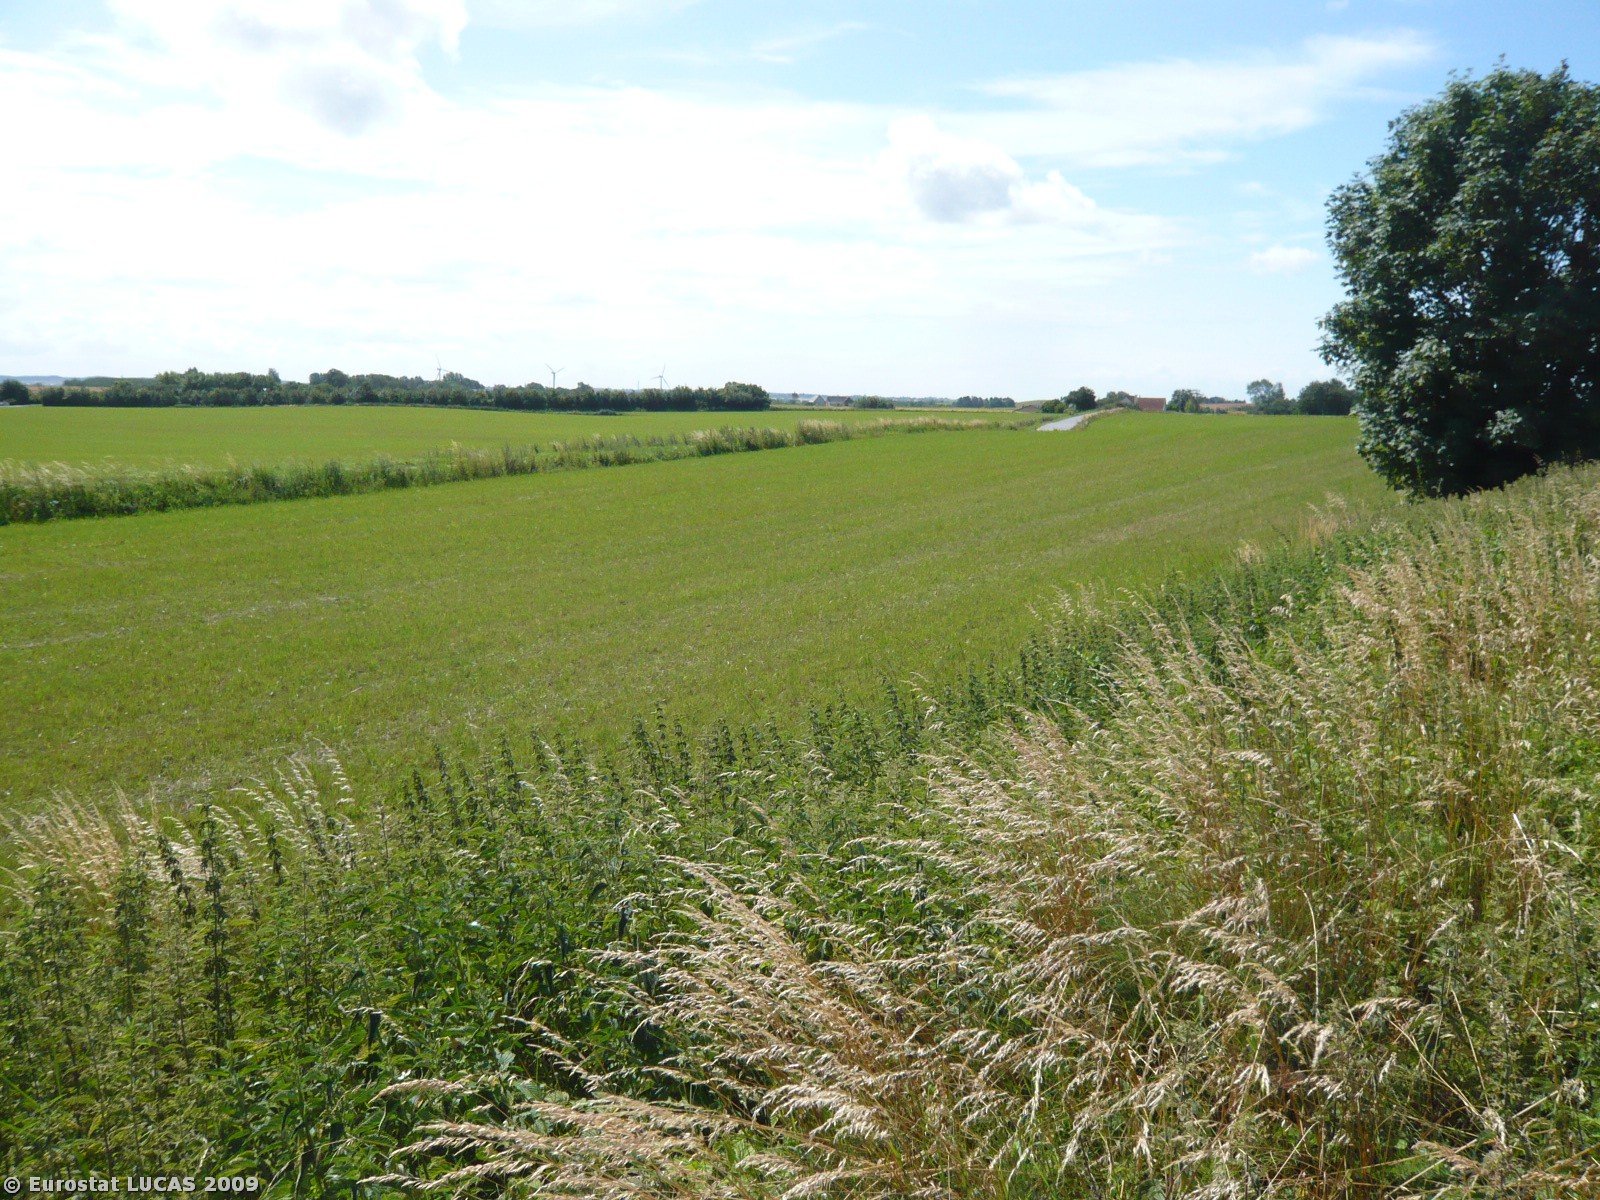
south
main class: Cropland
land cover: Barley
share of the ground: > 75 %
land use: Agriculture (excluding fallow land and kitchen gardens)
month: July
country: DK
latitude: 55.4796
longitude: 11.3437
